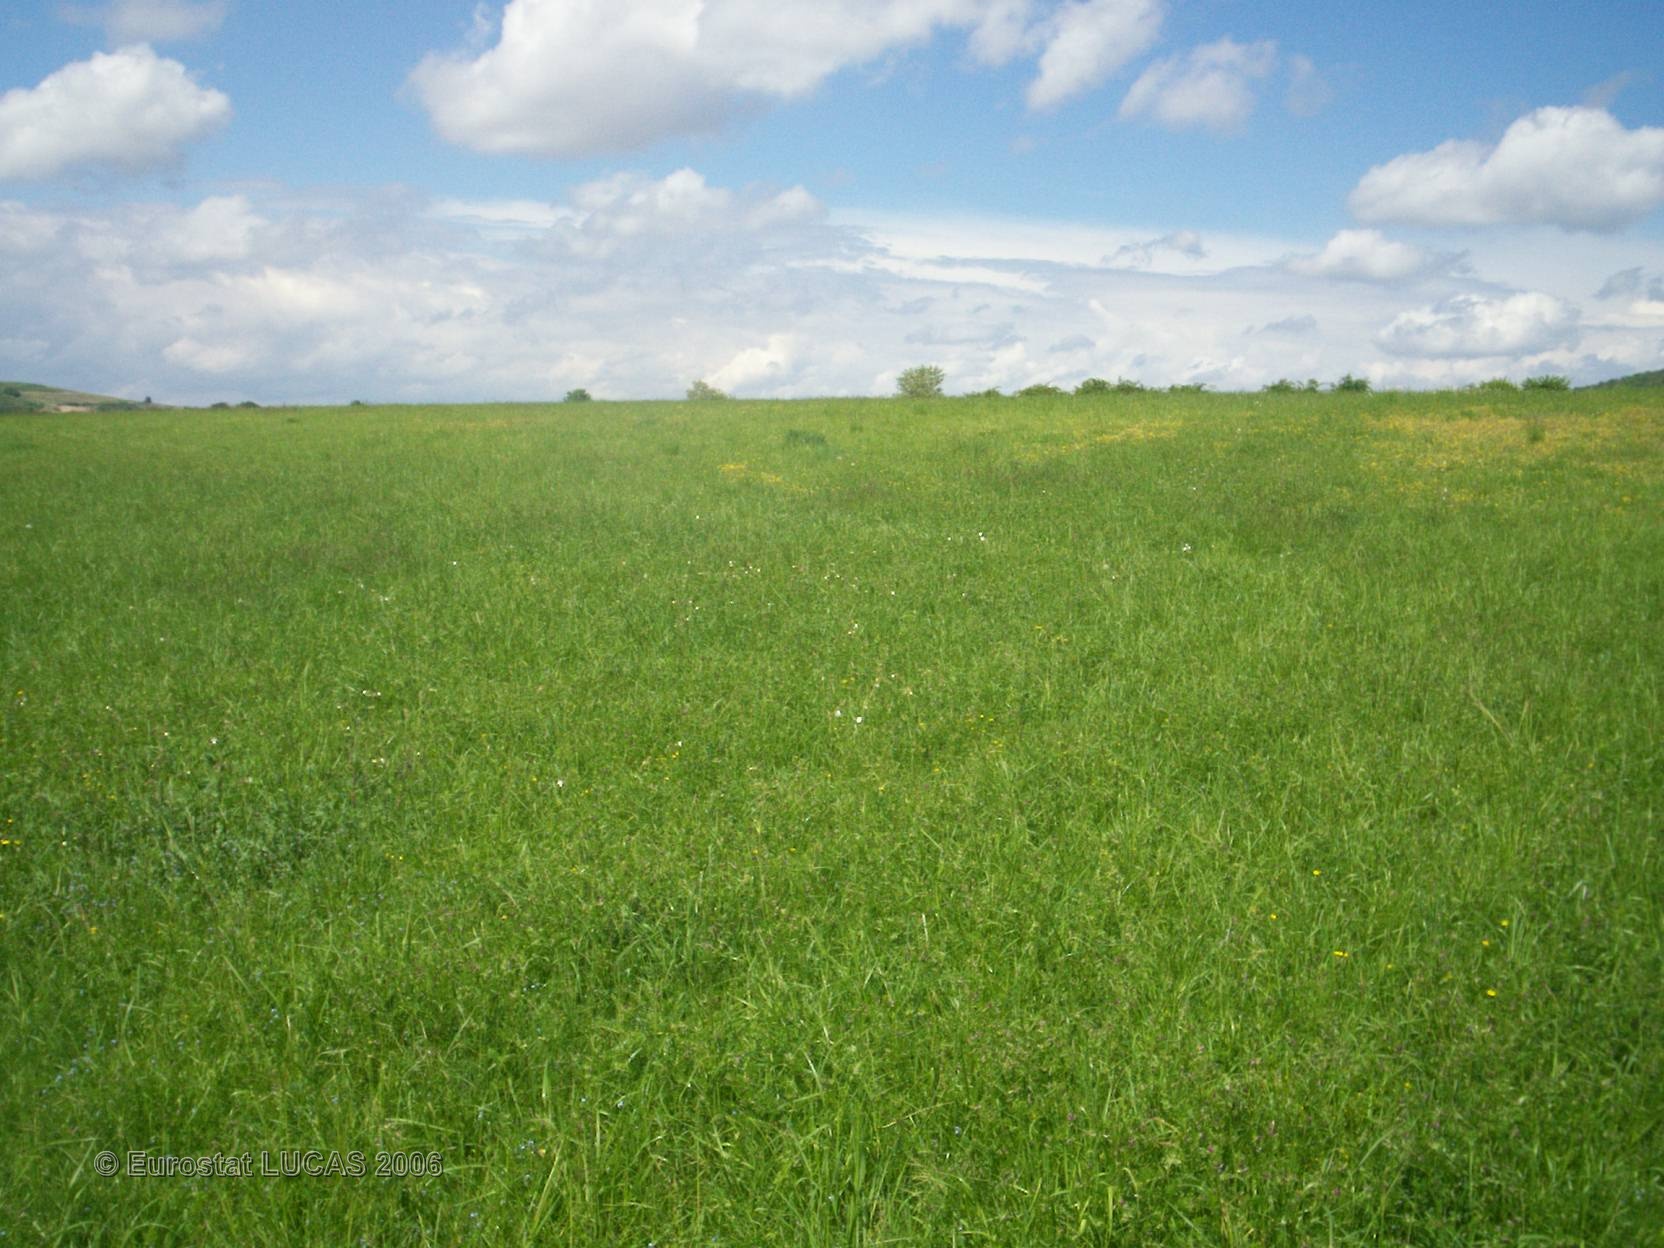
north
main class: Grassland
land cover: Grassland without tree/shrub cover
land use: Agriculture (excluding fallow land and kitchen gardens)
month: May
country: FR
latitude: 45.6834
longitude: 3.2084
